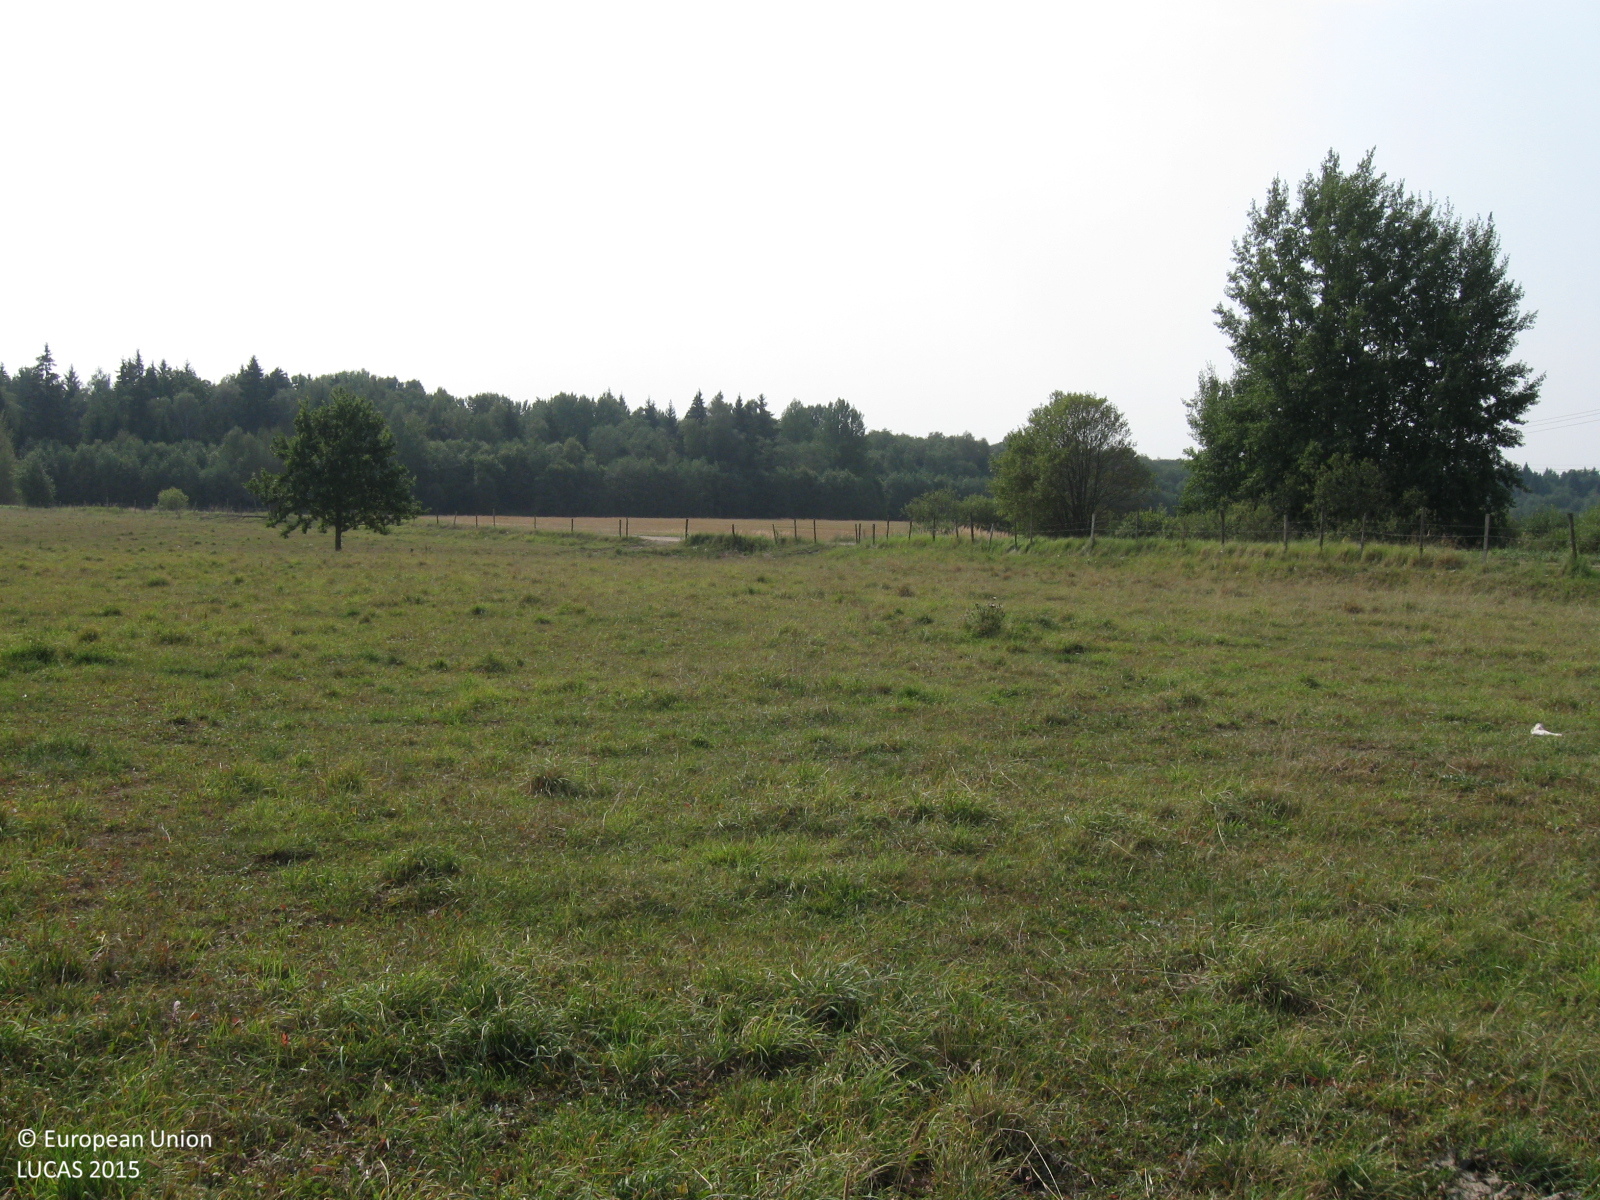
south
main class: Grassland
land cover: Grassland without tree/shrub cover
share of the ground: > 75 %
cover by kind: herbaceous plants 95 %, unconsolidated bare surface 5 %
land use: Agriculture (excluding fallow land and kitchen gardens)
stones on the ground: < 10 %
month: September
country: LT
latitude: 55.2224
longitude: 23.4249
